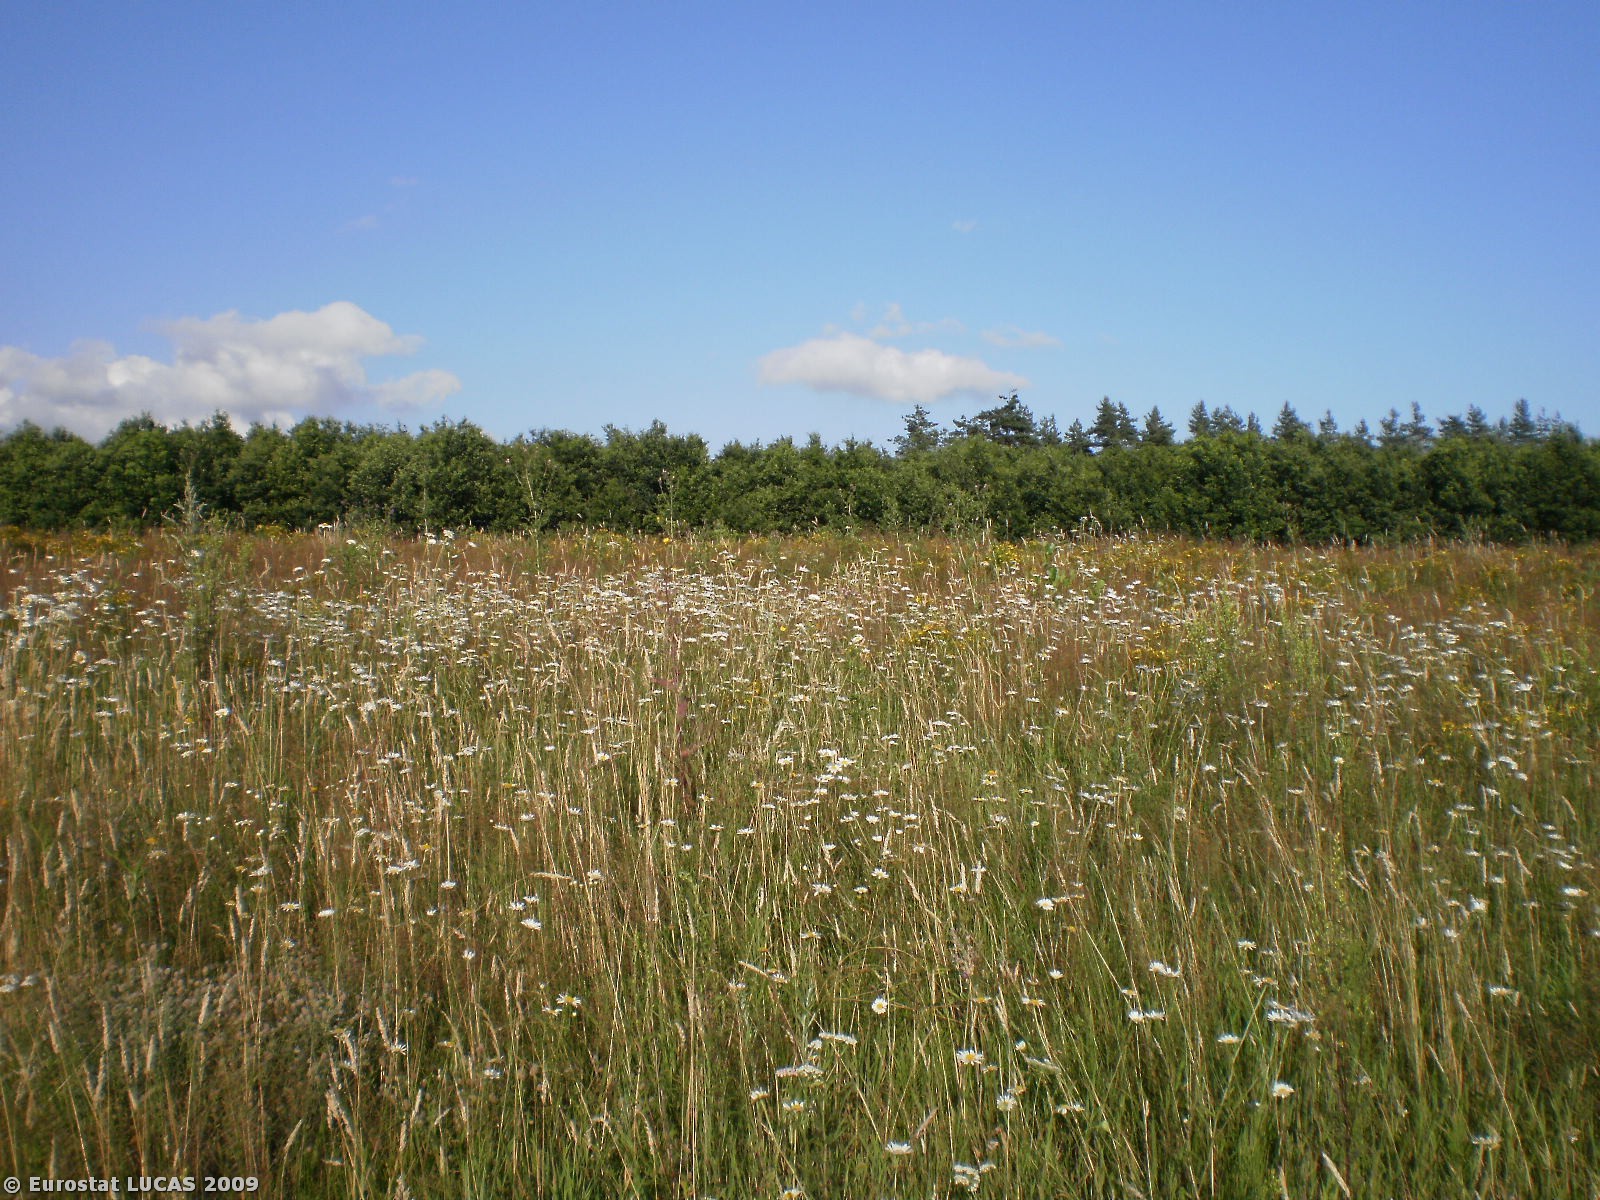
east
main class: Grassland
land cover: Grassland with sparse tree/shrub cover
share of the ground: > 75 %
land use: Unused
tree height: > 5 m
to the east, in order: Grassland with sparse tree/shrub cover; Grassland without tree/shrub cover; Broadleaved woodland; Fences; Broadleaved woodland
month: July
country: PL
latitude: 53.9691
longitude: 20.6021
